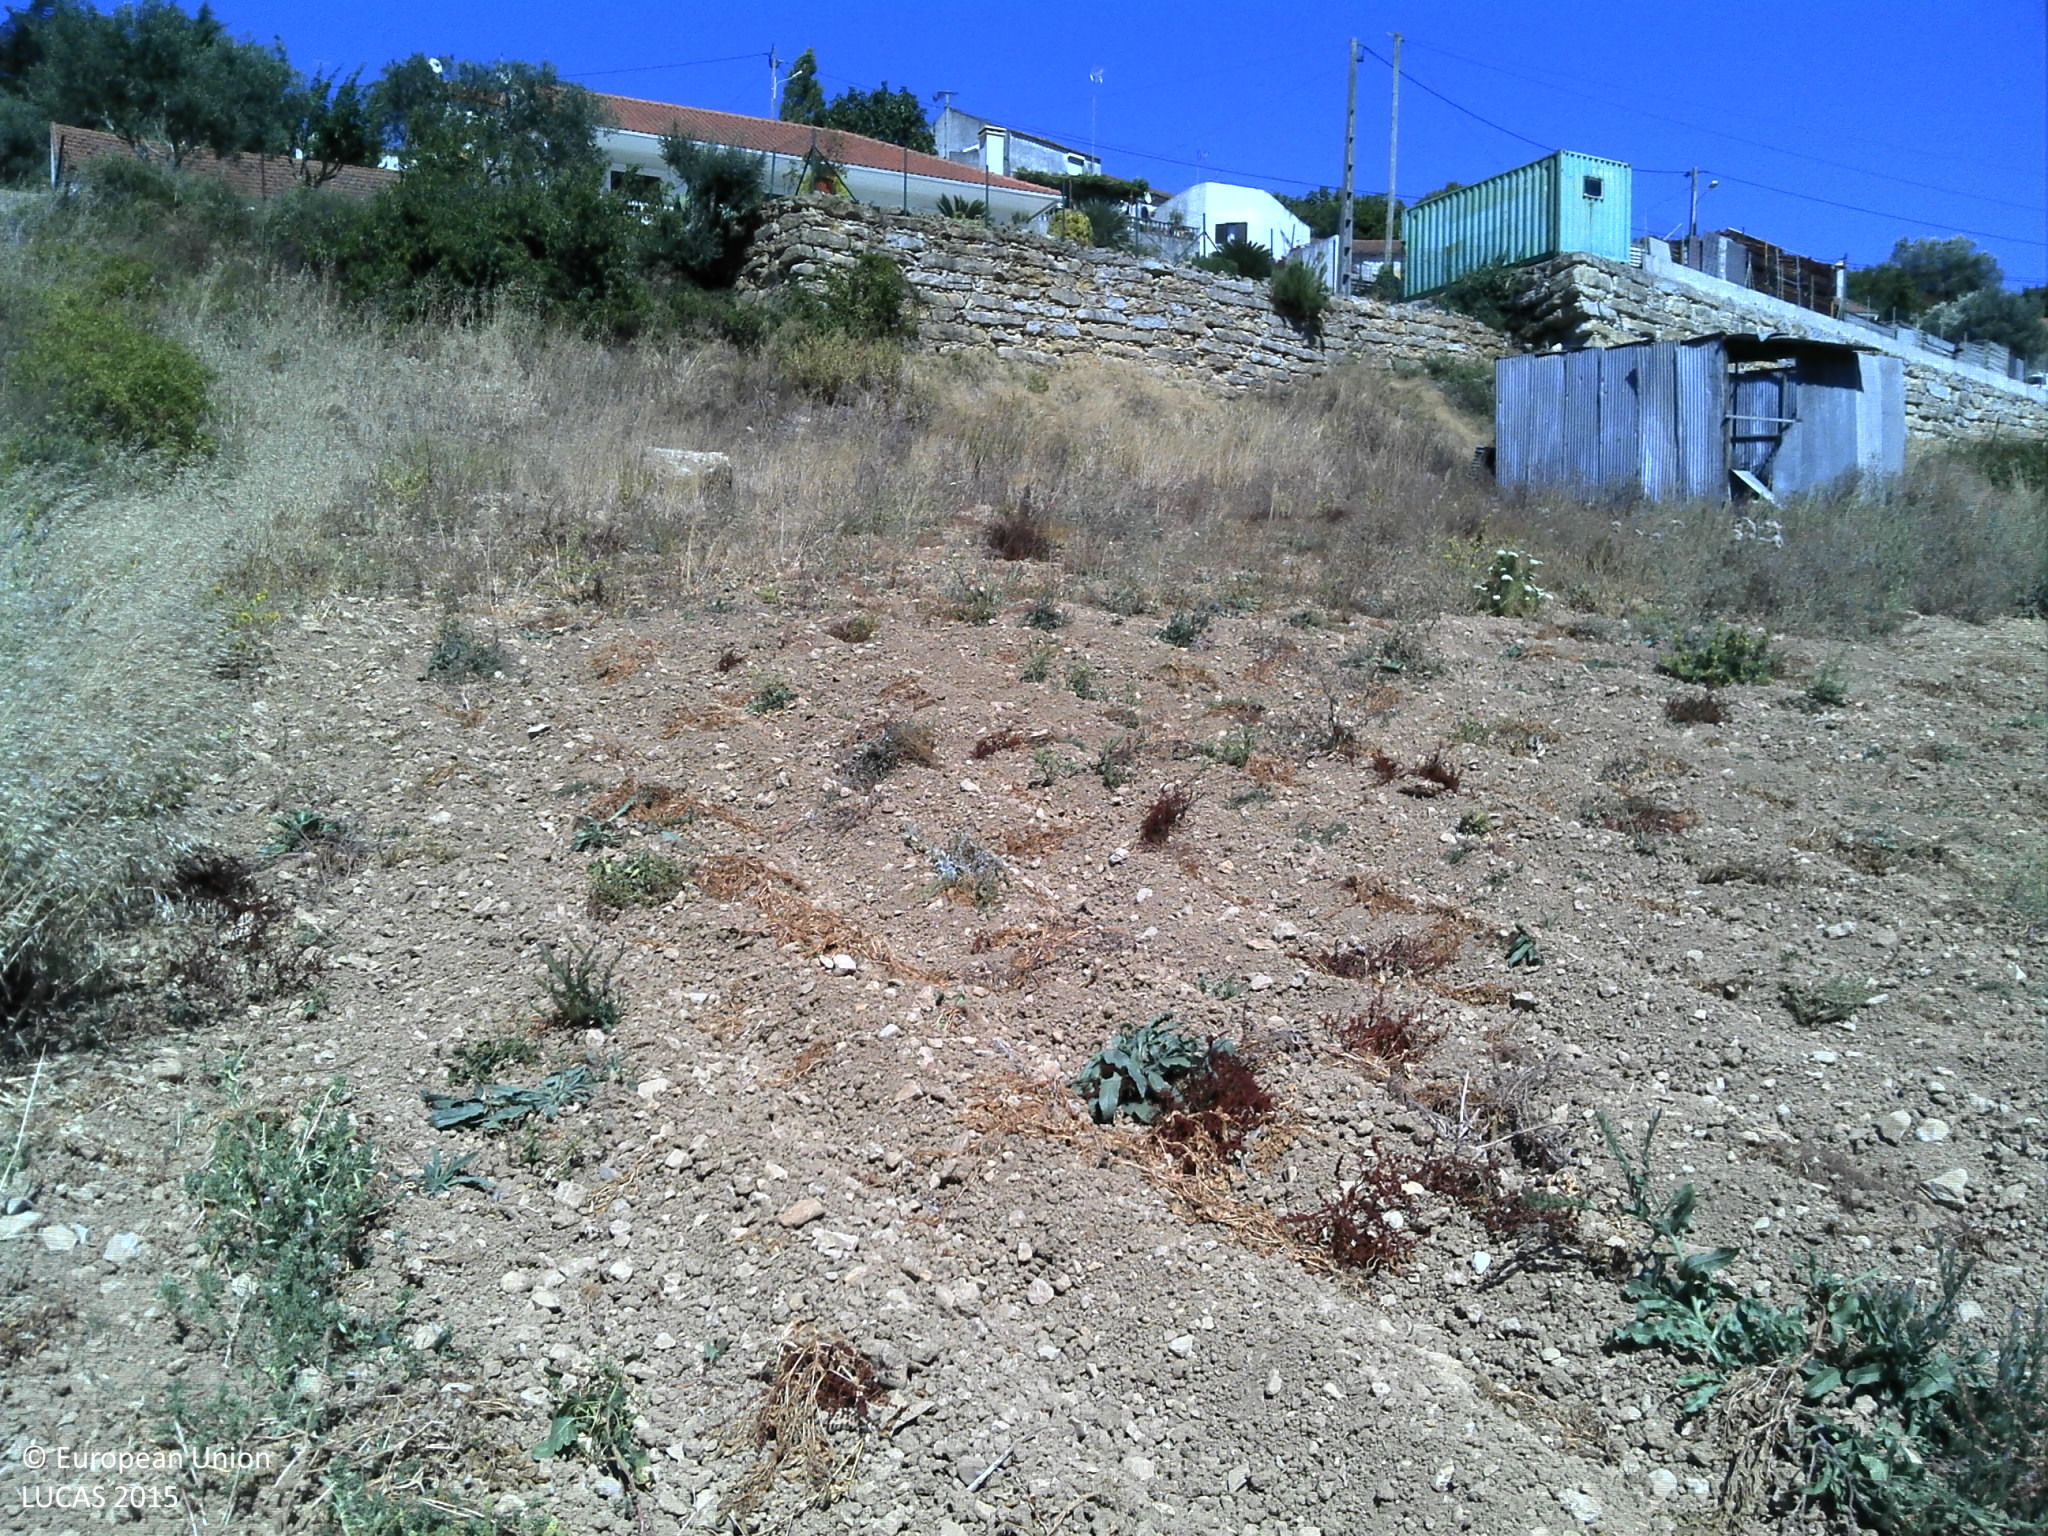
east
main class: Grassland
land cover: Spontaneously vegetated surfaces
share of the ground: 10 - 25 %
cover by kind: unconsolidated bare surface 75 %, herbaceous plants 15 %
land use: Fallow land
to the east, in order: Spontaneously vegetated surfaces; Grassland without tree/shrub cover; Other fruit trees and berries; Grassland without tree/shrub cover; Artificial constructions in urban areas; Single bushes/trees; Grassland without tree/shrub cover; Spontaneously vegetated surfaces; Shrubland with sparse tree cover; Grassland without tree/shrub cover
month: July
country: PT
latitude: 38.9835
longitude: -9.1873
